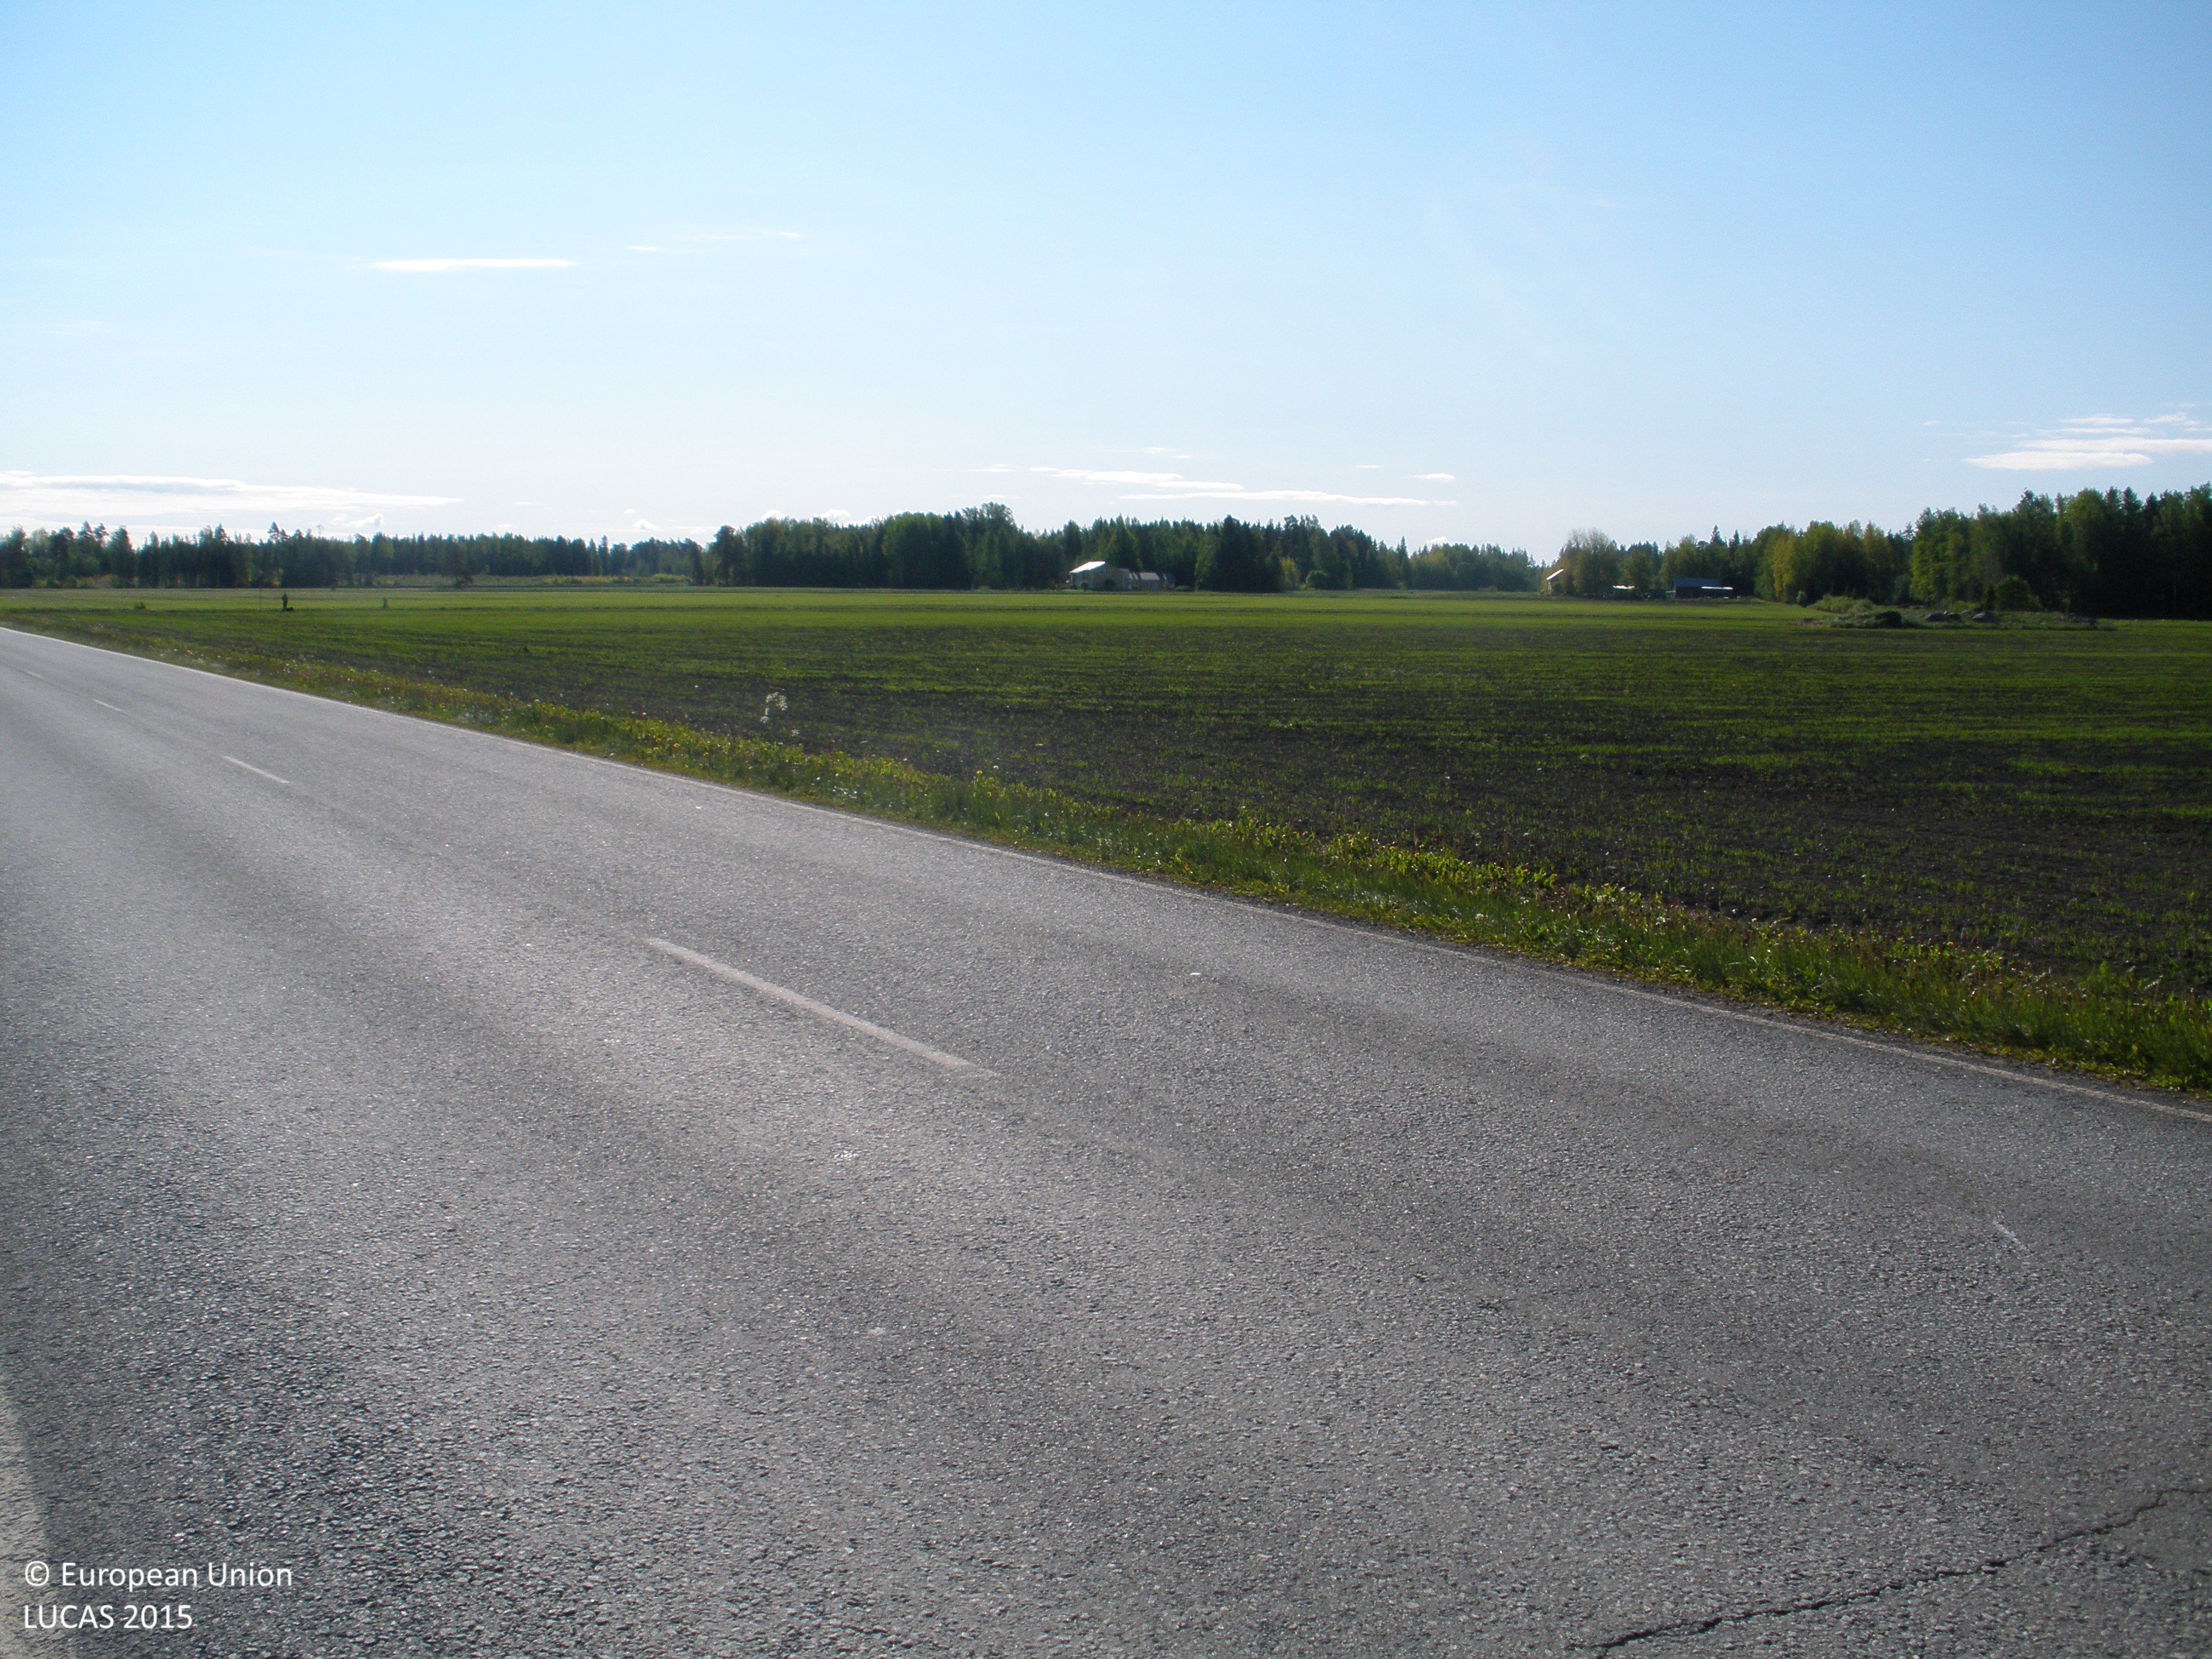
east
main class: Cropland
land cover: Oats
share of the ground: > 75 %
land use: Agriculture (excluding fallow land and kitchen gardens)
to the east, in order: Oats; Grass margins; Ditches and canals; Grass margins; Paved roads, cycling and walking lanes; Grass margins; Ditches and canals; Grass margins; Paved roads, cycling and walking lanes; Grass margins; Ditches and canals; Grass margins; Barley
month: June
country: FI
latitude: 60.9272
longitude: 23.6085
